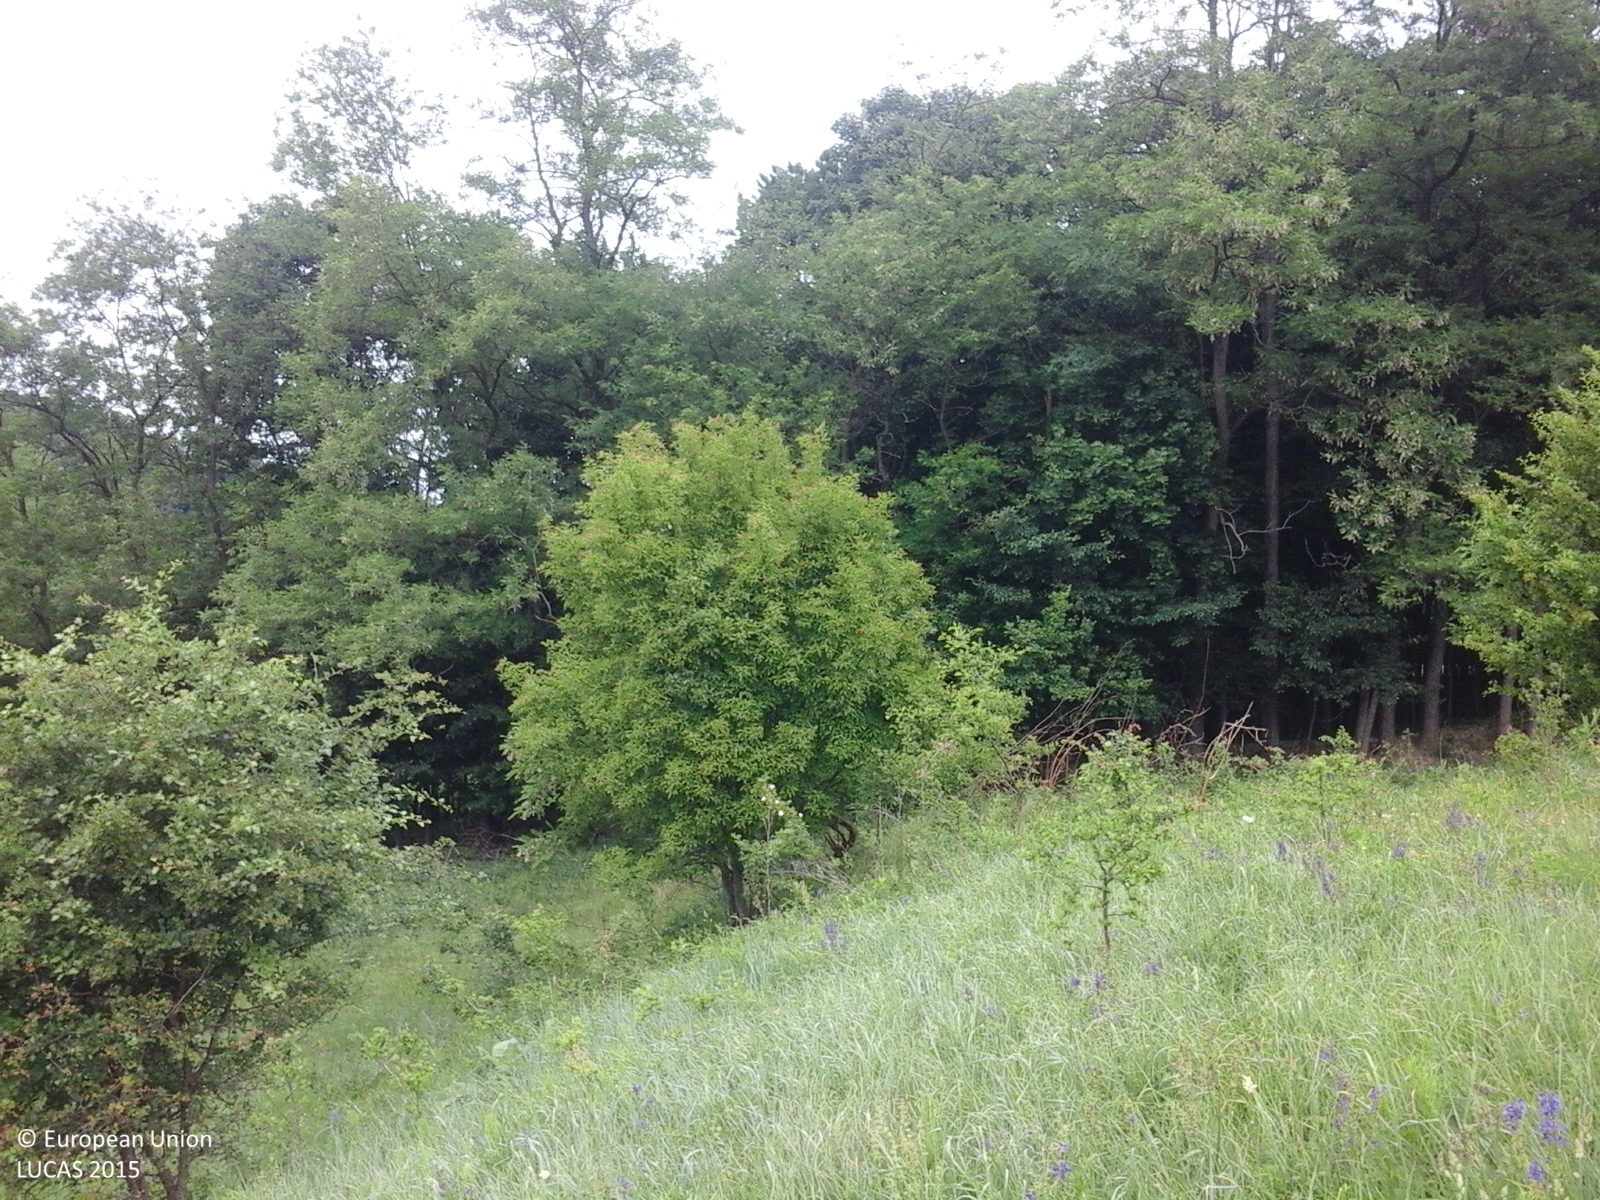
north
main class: Grassland
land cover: Grassland with sparse tree/shrub cover
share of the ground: > 75 %
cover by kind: herbaceous plants 90 %, broadleaved forest trees 5 %, shrubs 5 %
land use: Agriculture (excluding fallow land and kitchen gardens)
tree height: < 5 m
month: June
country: RO
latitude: 47.0144
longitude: 26.6786
